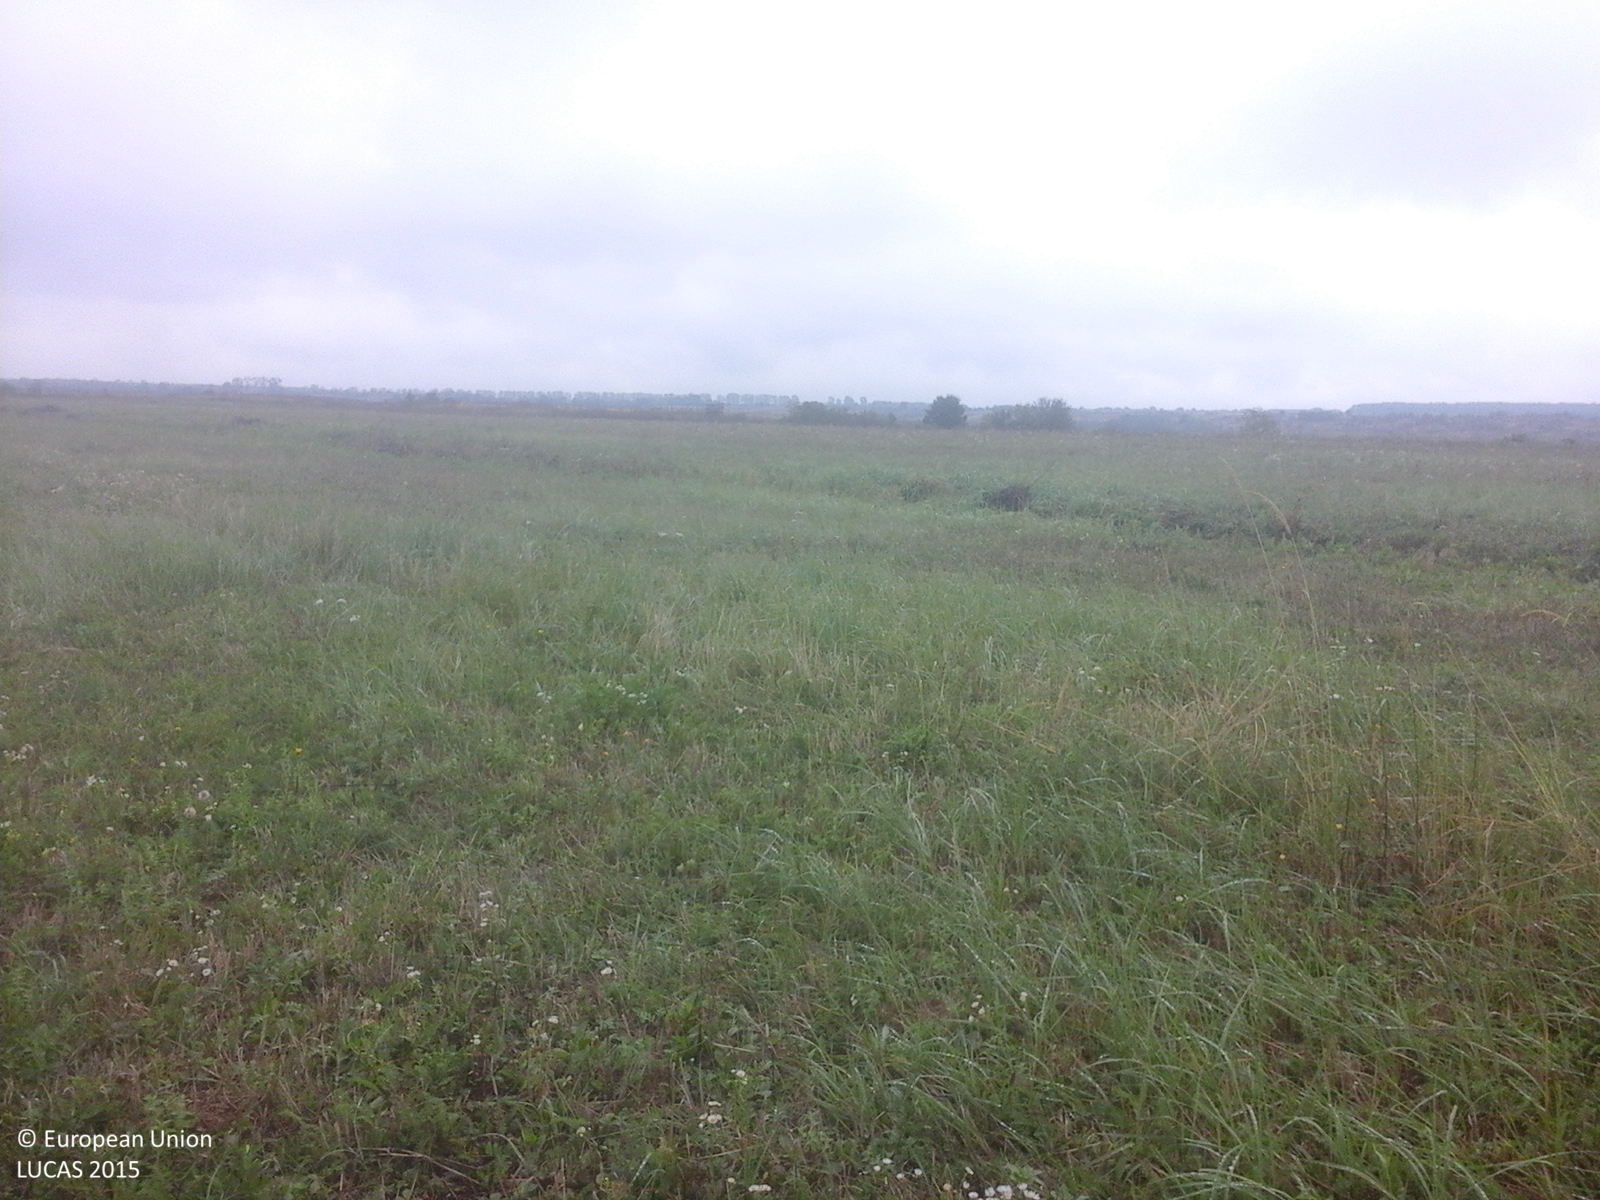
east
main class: Grassland
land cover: Grassland without tree/shrub cover
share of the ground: > 75 %
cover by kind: herbaceous plants 100 %
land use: Agriculture (excluding fallow land and kitchen gardens)
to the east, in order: Grassland without tree/shrub cover; Ditches and canals; Spontaneously vegetated surfaces; Grassland without tree/shrub cover; Shruby margins; Other bare soil; Ditches and canals; Abandoned hedges; Grassland without tree/shrub cover; Spontaneously vegetated surfaces
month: September
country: RO
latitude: 46.8151
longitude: 22.0386
